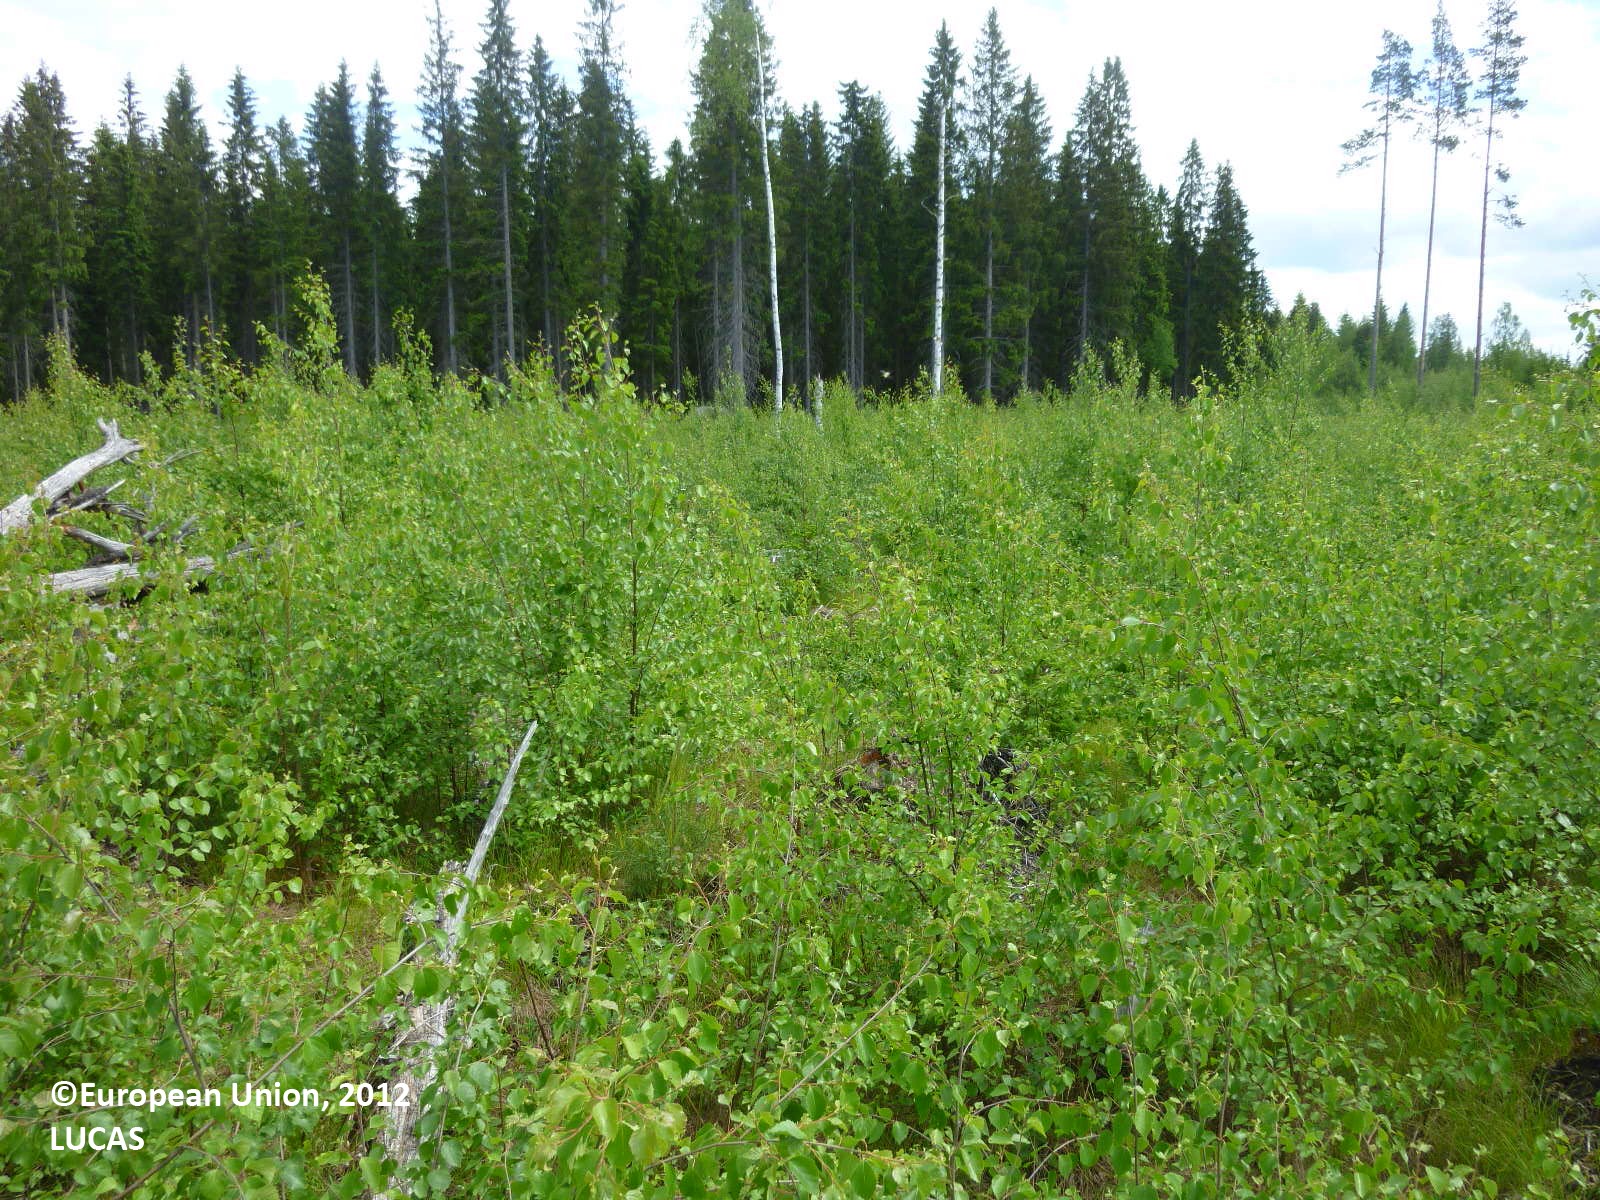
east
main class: Woodland
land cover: Broadleaved woodland
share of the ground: 50 - 75 %
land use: Forestry
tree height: > 5 m
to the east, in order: Broadleaved woodland; Ditches and canals; Grassland with sparse tree/shrub cover; Spruce dominated coniferous woodland; Grassland with sparse tree/shrub cover; Ditches and canals; Spruce dominated mixed woodland; Grassland with sparse tree/shrub cover; Spruce dominated mixed woodland; Other coniferous woodland; Paved roads, cycling and walking lanes
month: June
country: FI
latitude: 61.4459
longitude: 22.5358
